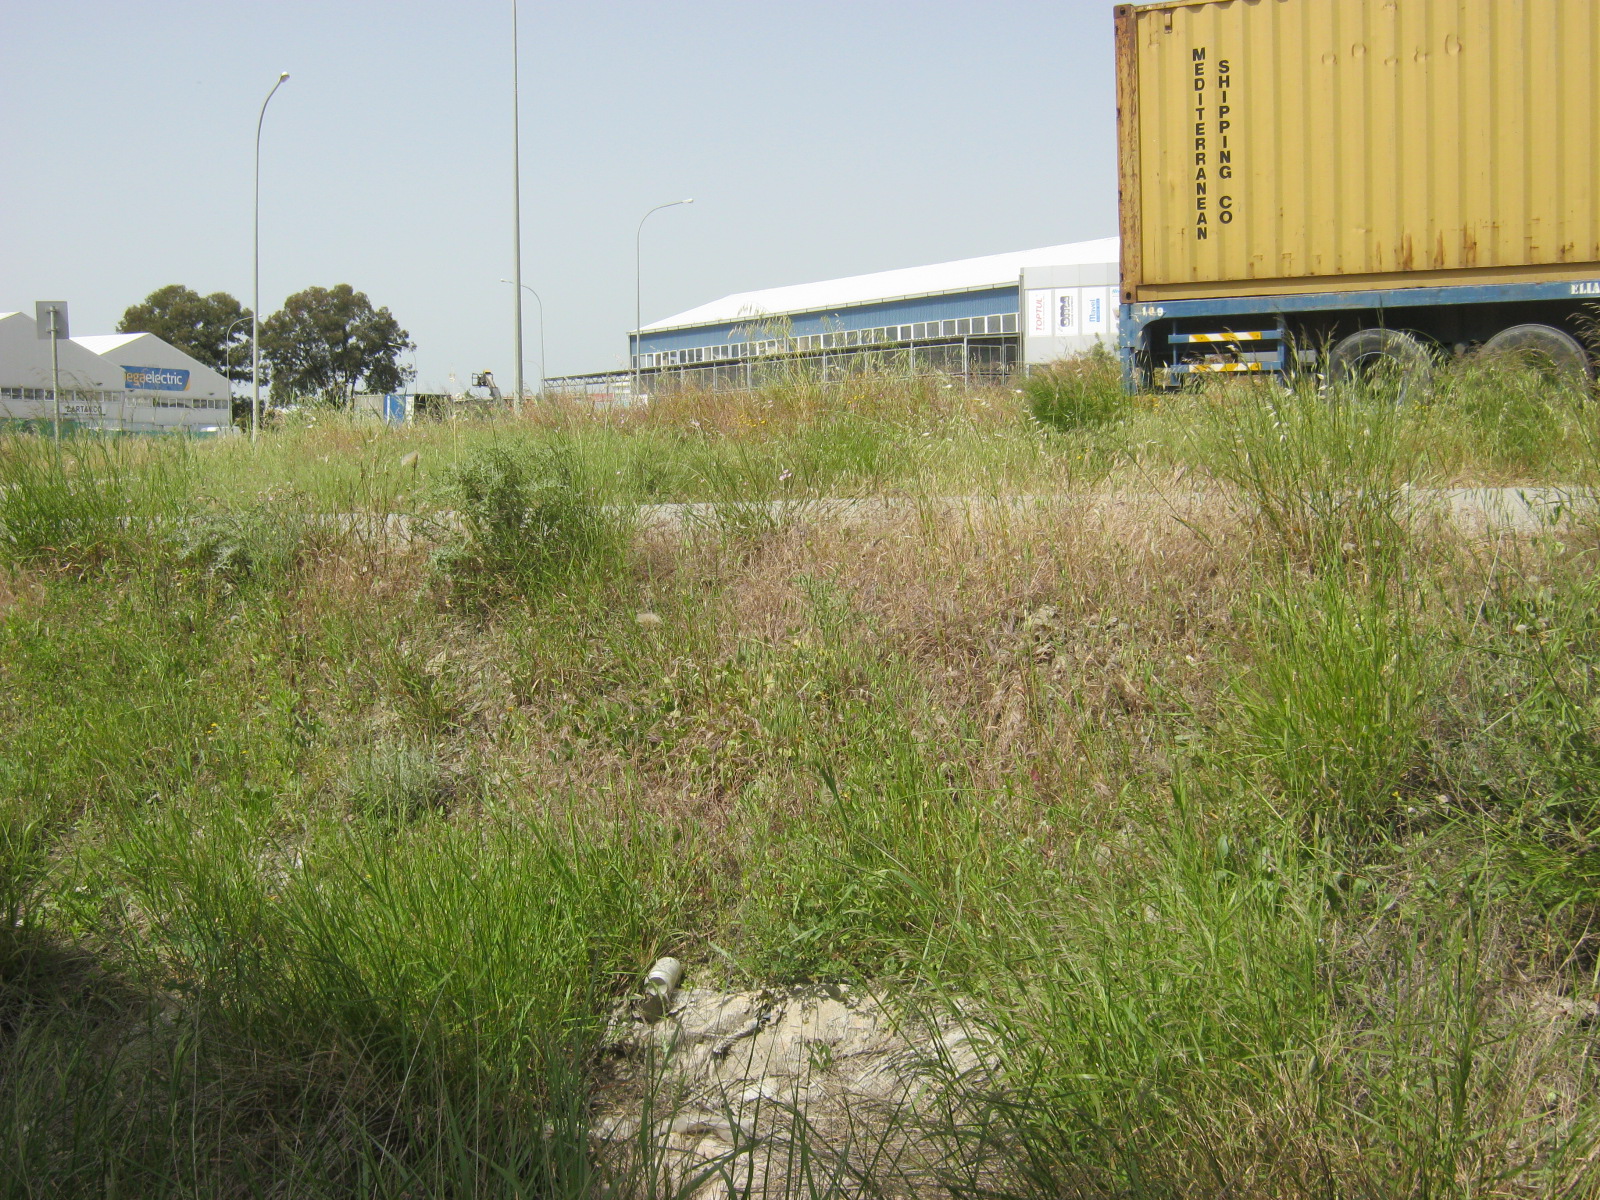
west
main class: Grassland
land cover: Spontaneously vegetated surfaces
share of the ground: > 75 %
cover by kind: herbaceous plants 100 %
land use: Logistics and storage
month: April
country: CY
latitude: 35.0473
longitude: 33.4003
